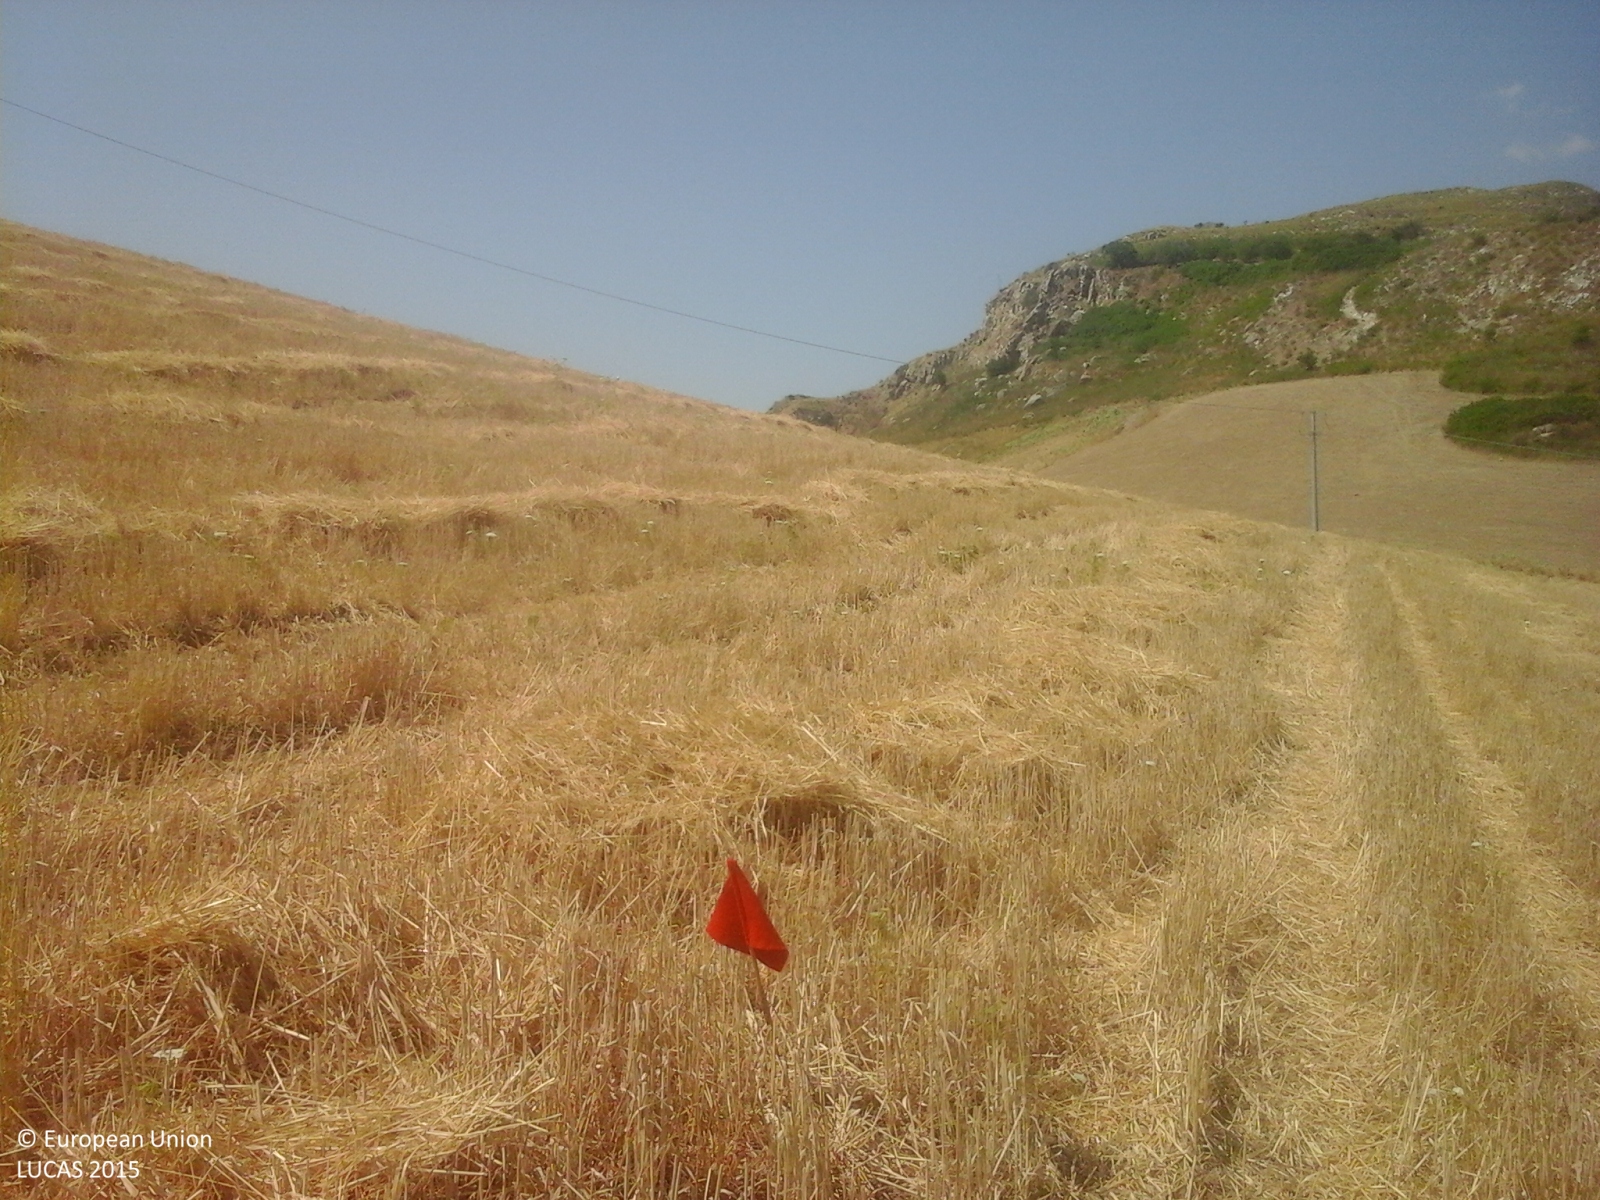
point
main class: Cropland
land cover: Durum wheat
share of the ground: > 75 %
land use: Agriculture (excluding fallow land and kitchen gardens)
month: July
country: IT
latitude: 37.4646
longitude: 13.5120
